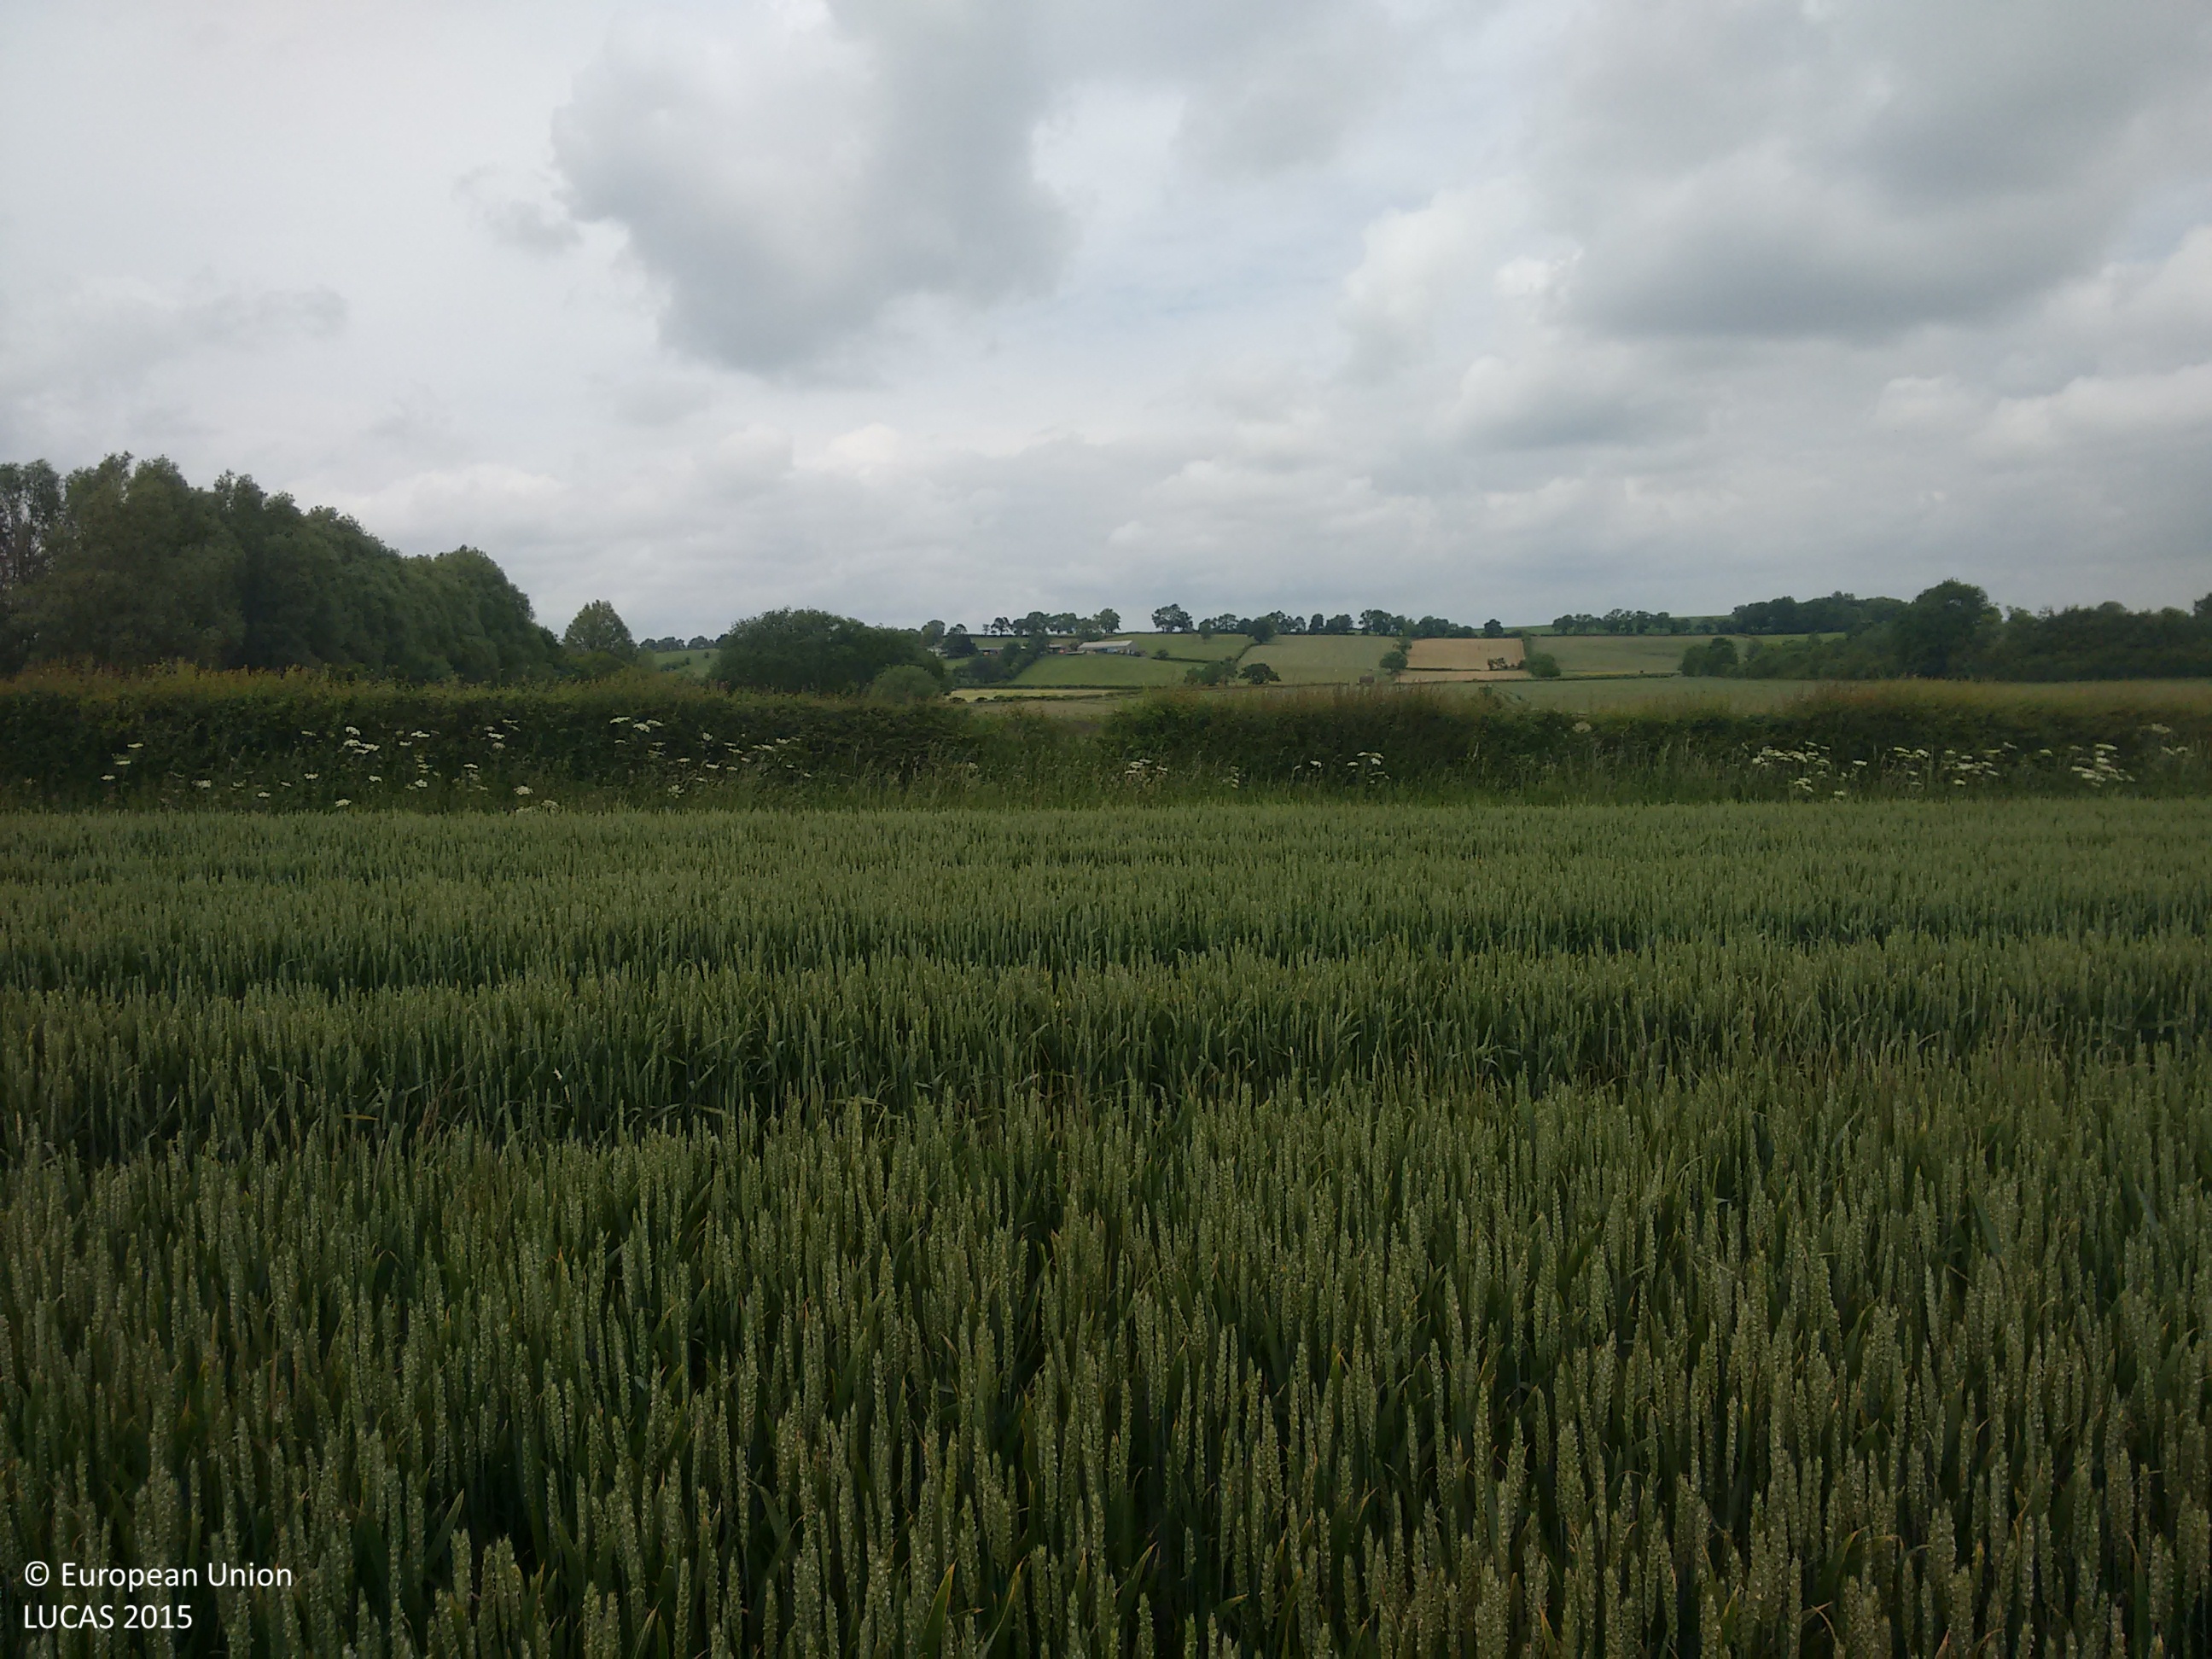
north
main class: Cropland
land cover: Common wheat
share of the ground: > 75 %
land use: Agriculture (excluding fallow land and kitchen gardens)
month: June
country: GB
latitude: 54.2343
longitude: -0.8876
